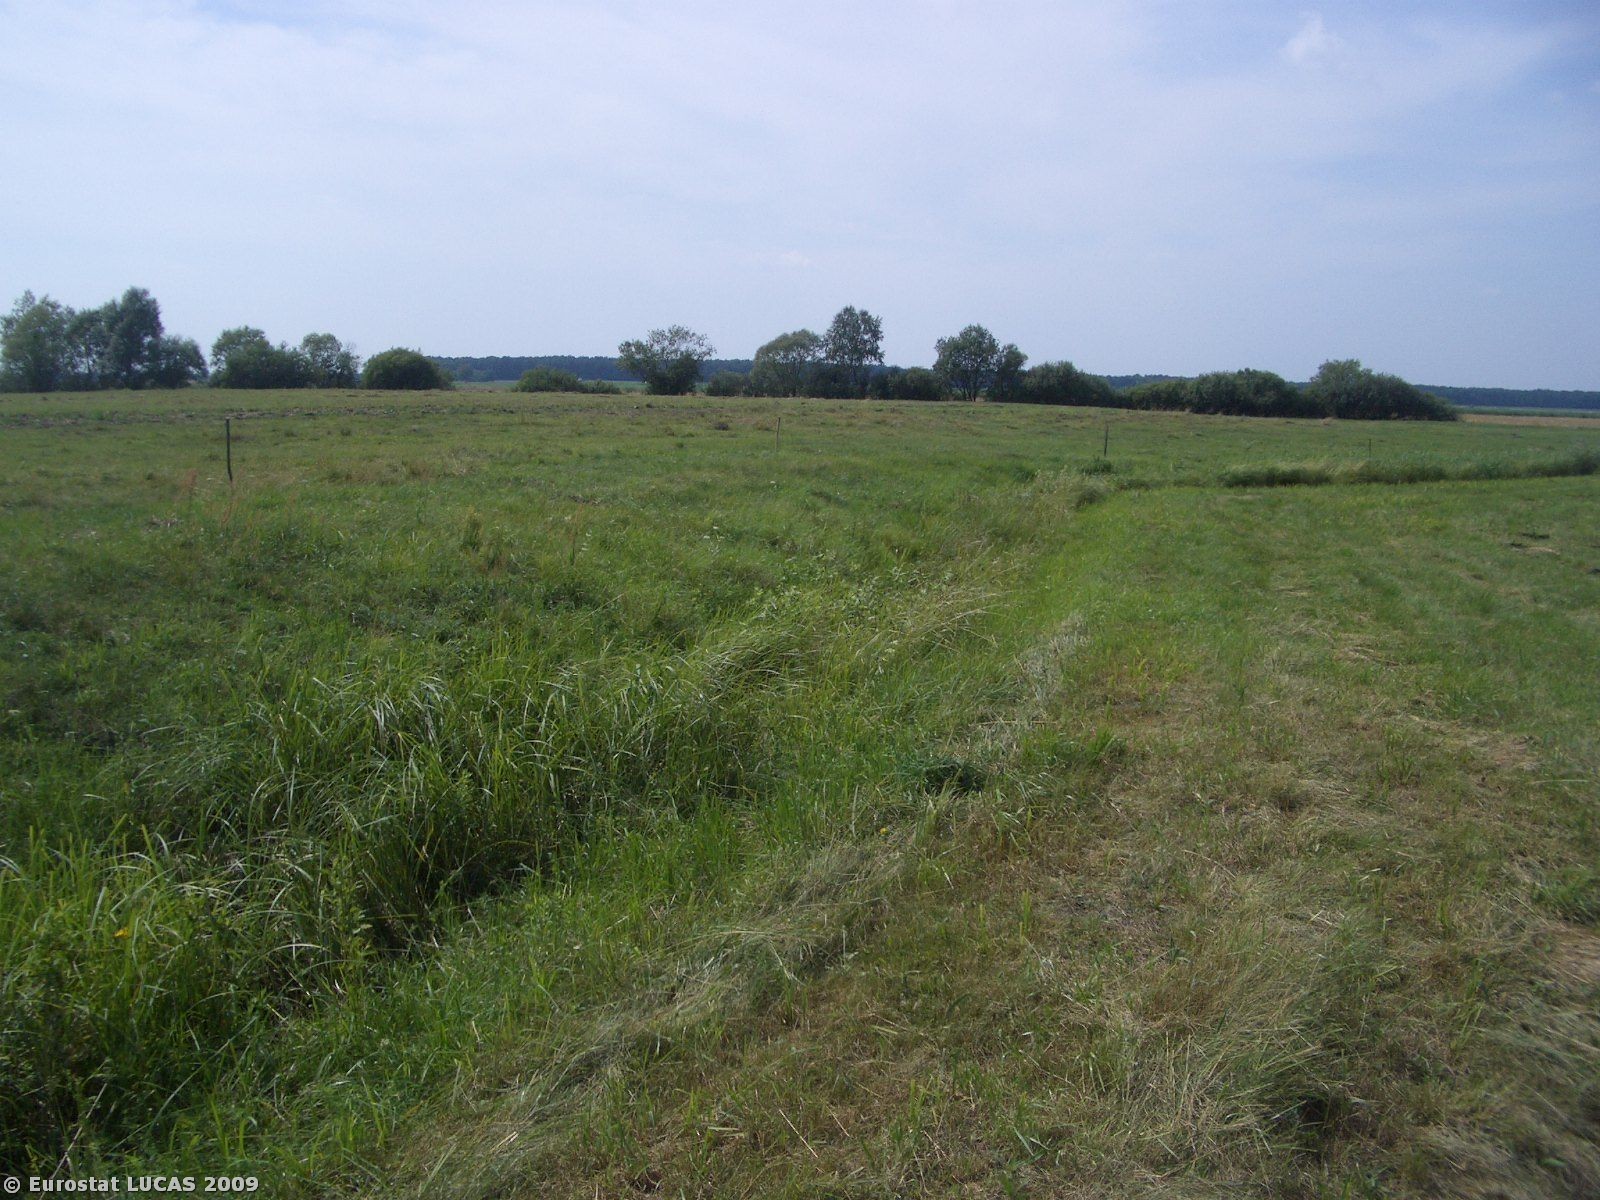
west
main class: Grassland
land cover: Grassland without tree/shrub cover
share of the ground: > 75 %
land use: Agriculture (excluding fallow land and kitchen gardens)
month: July
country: PL
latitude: 51.4471
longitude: 23.0988
